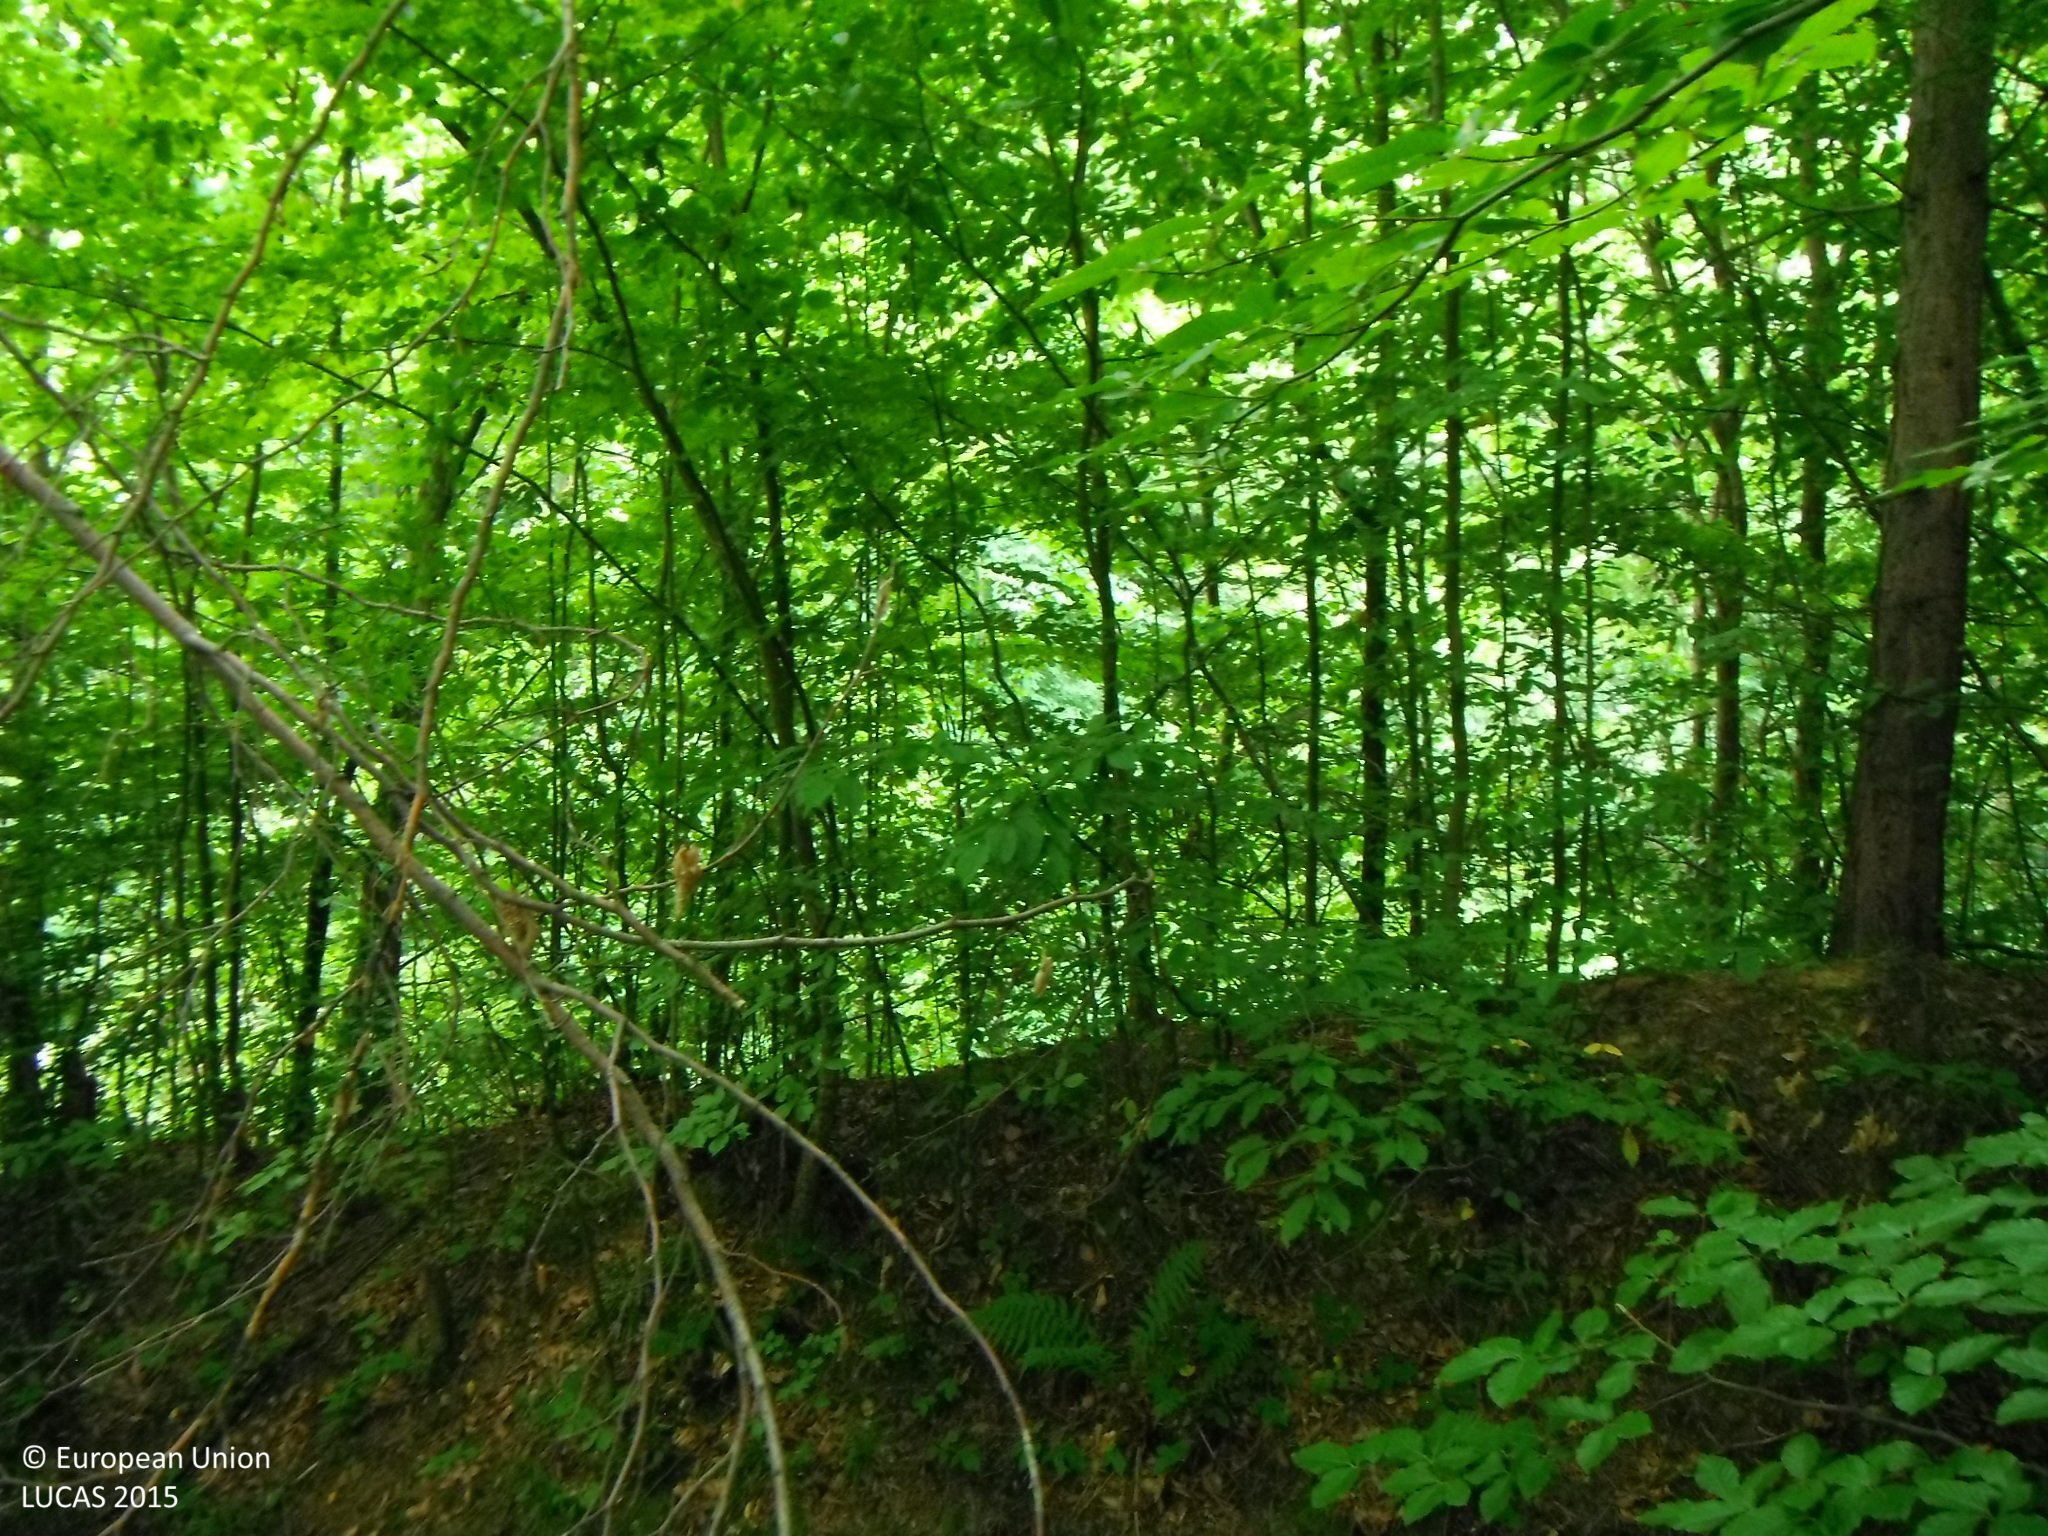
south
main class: Woodland
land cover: Broadleaved woodland
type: beech forest
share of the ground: > 75 %
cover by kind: broadleaved forest trees 100 %
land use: Forestry
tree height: > 5 m
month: July
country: SK
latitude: 49.3515
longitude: 21.2655
